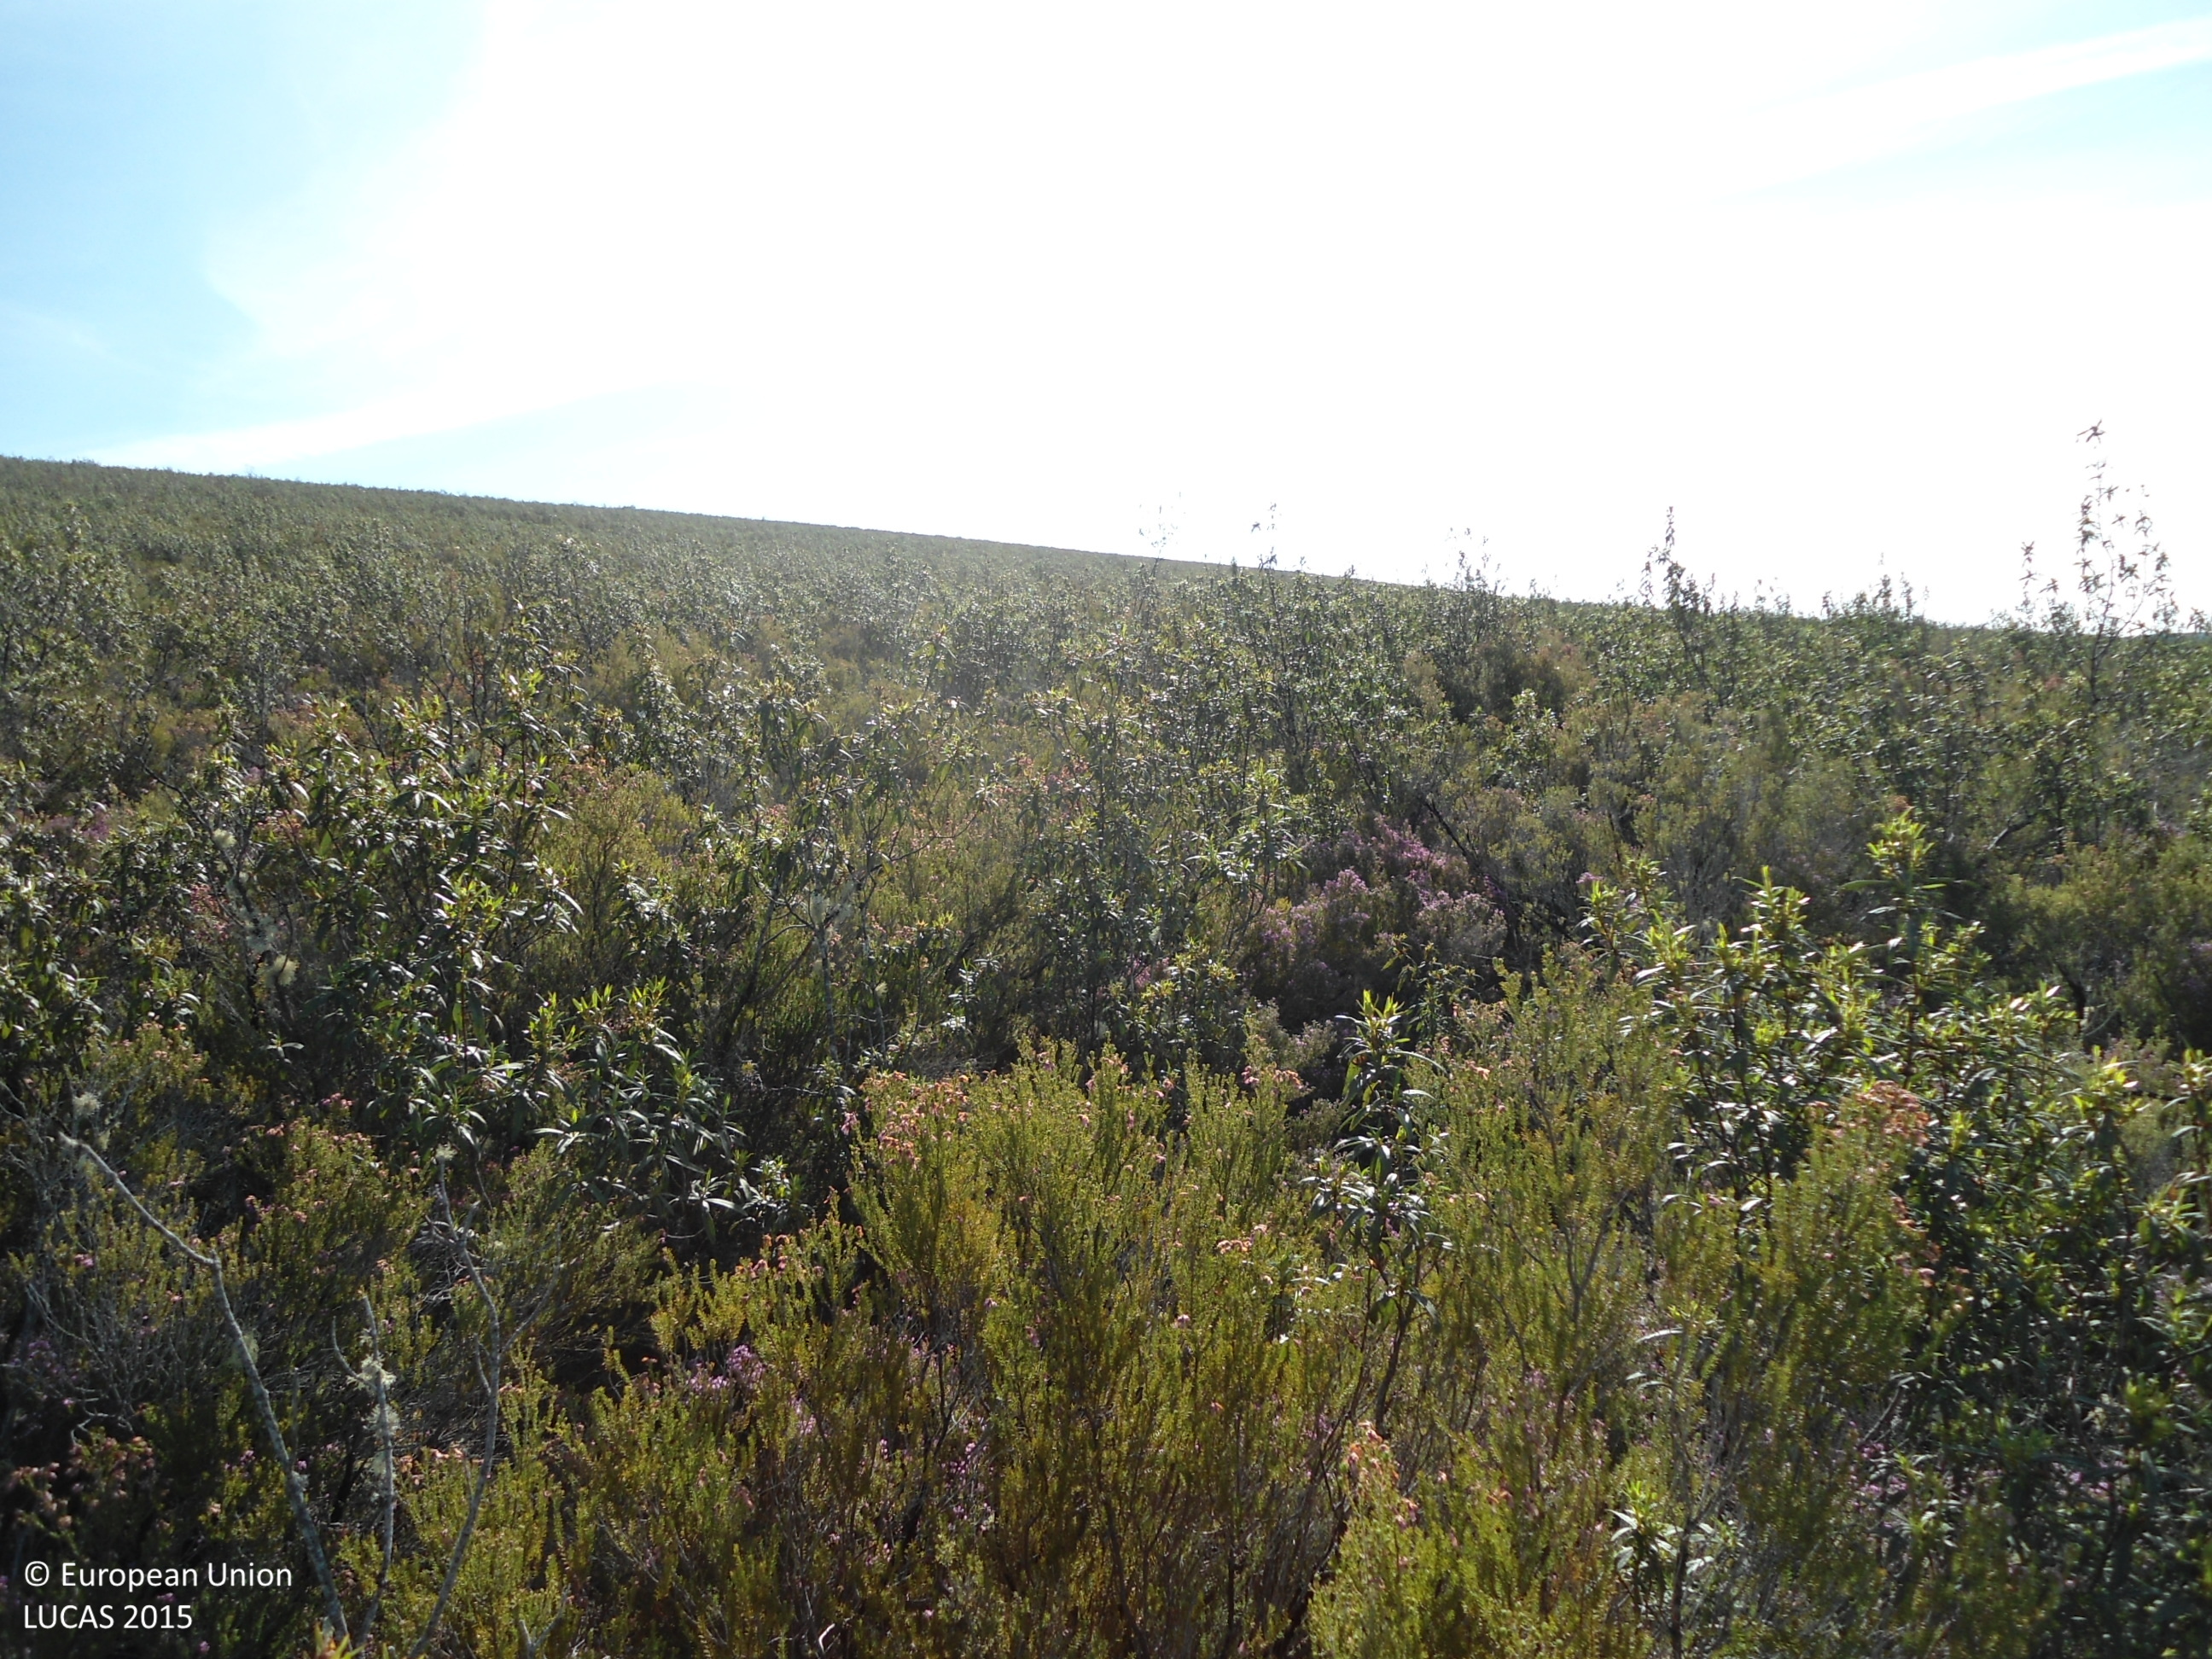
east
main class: Shrubland
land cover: Shrubland without tree cover
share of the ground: > 75 %
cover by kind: shrubs 100 %
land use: Semi-natural and natural areas not in use
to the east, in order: Shrubland without tree cover
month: April
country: ES
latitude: 41.7870
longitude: -6.1630
